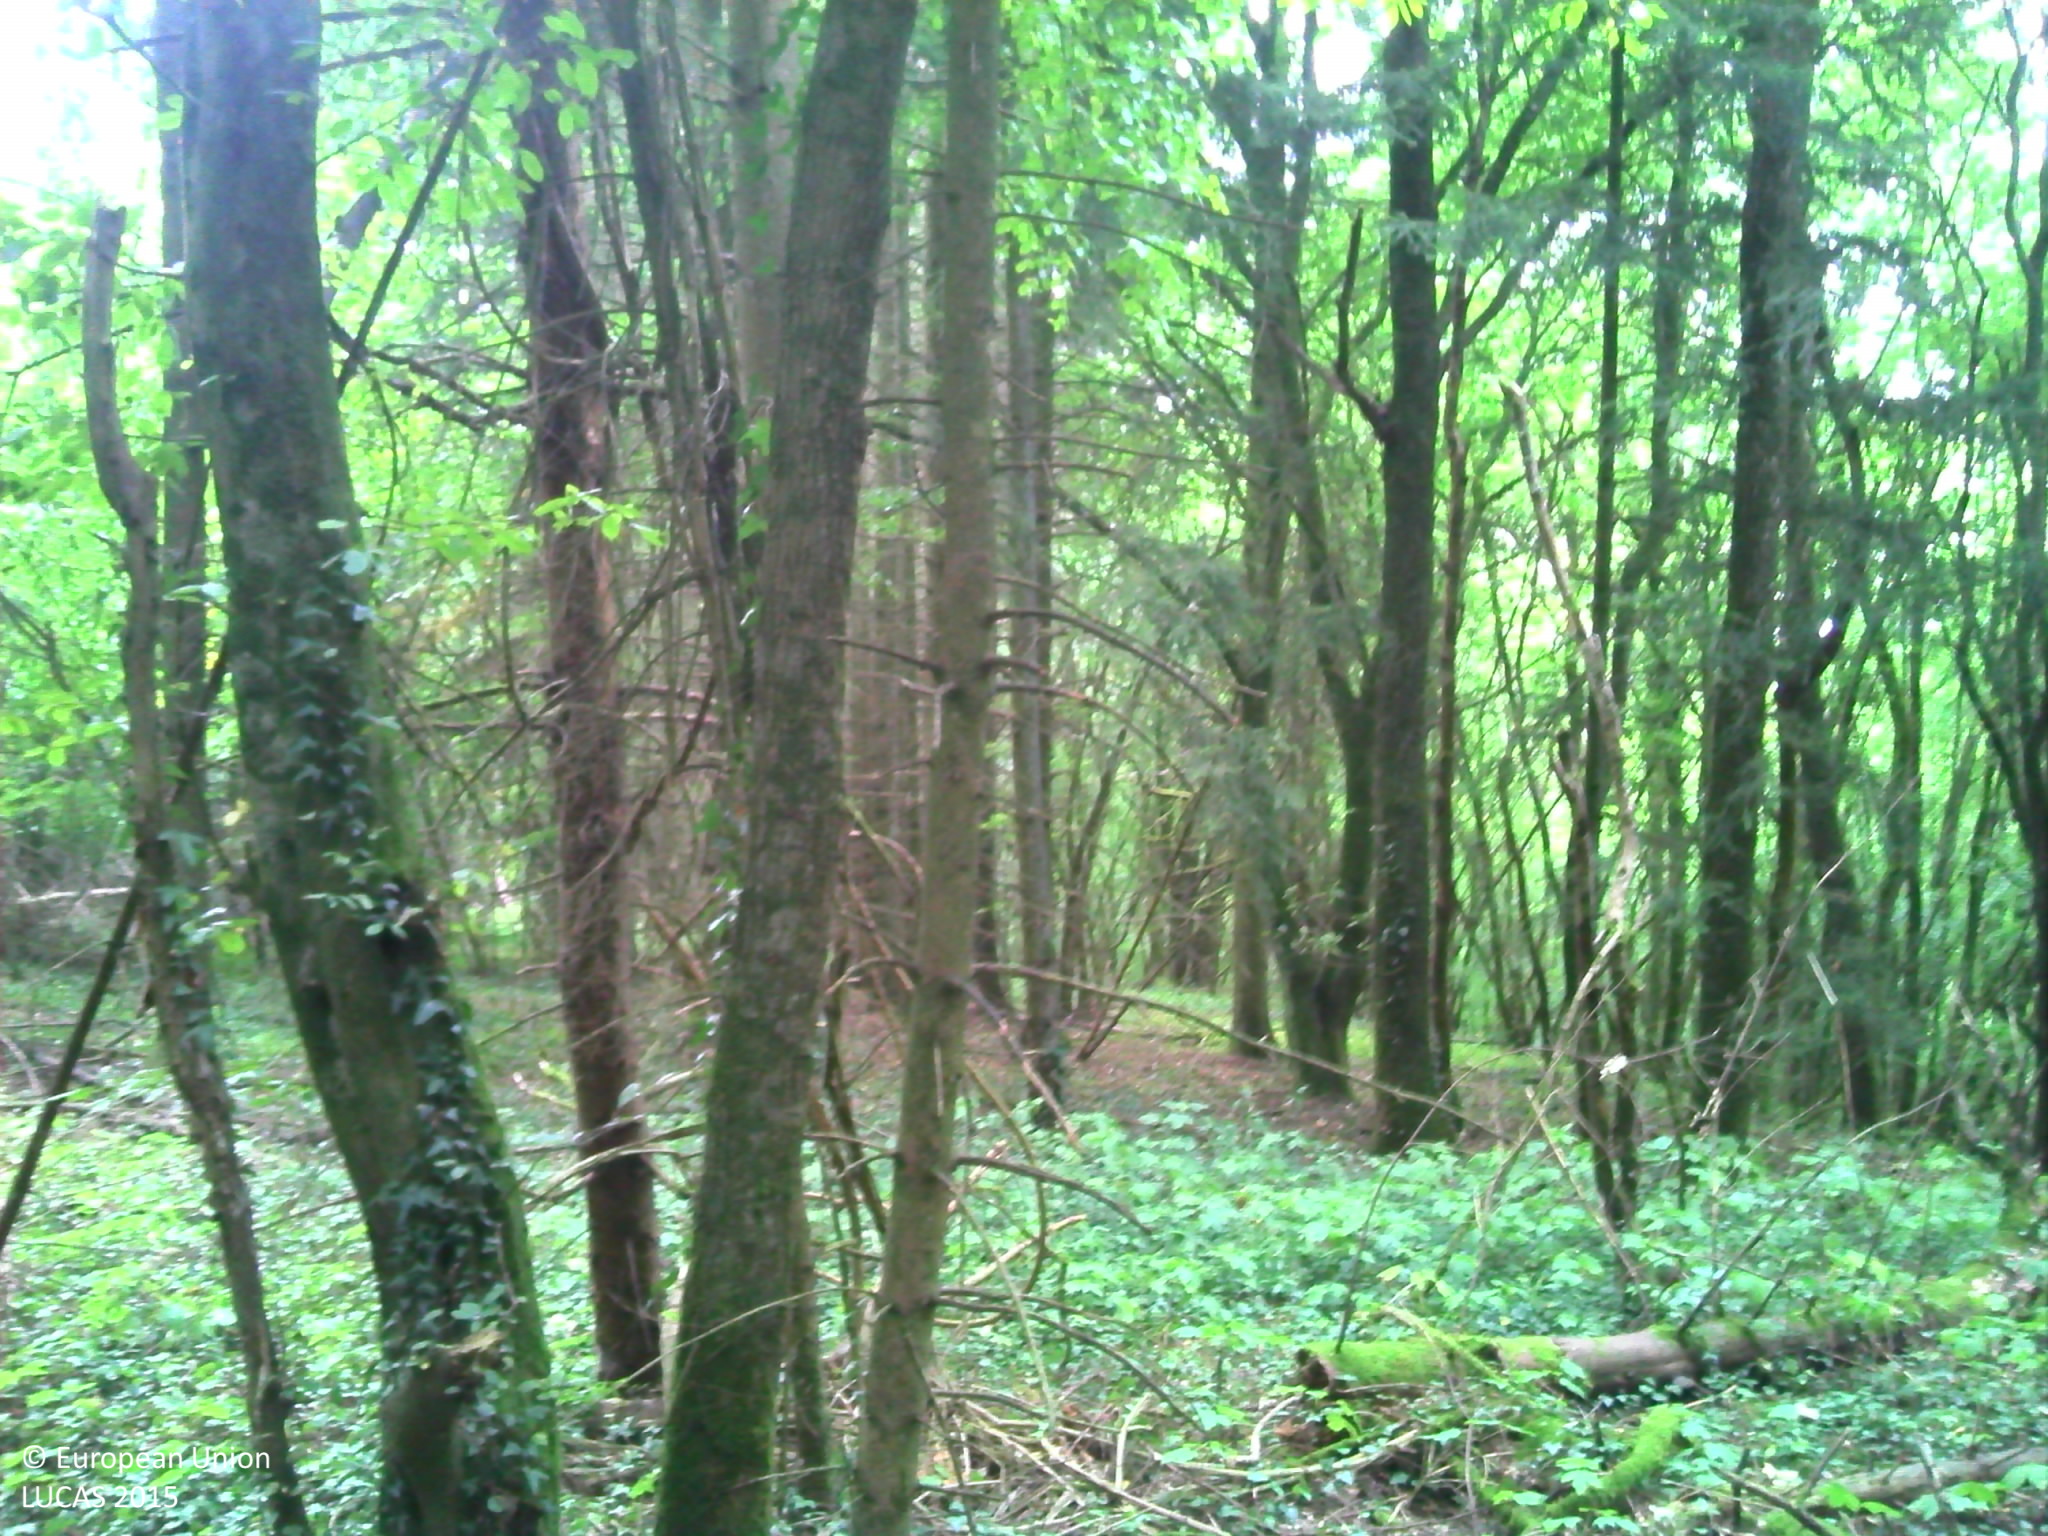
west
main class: Woodland
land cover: Spruce dominated coniferous woodland
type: mesophytic deciduous forest
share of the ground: > 75 %
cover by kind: coniferous forest trees 80 %, broadleaved forest trees 15 %, unconsolidated bare surface 5 %
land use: Forestry
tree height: > 5 m
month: August
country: FR
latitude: 49.3646
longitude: 5.2475
